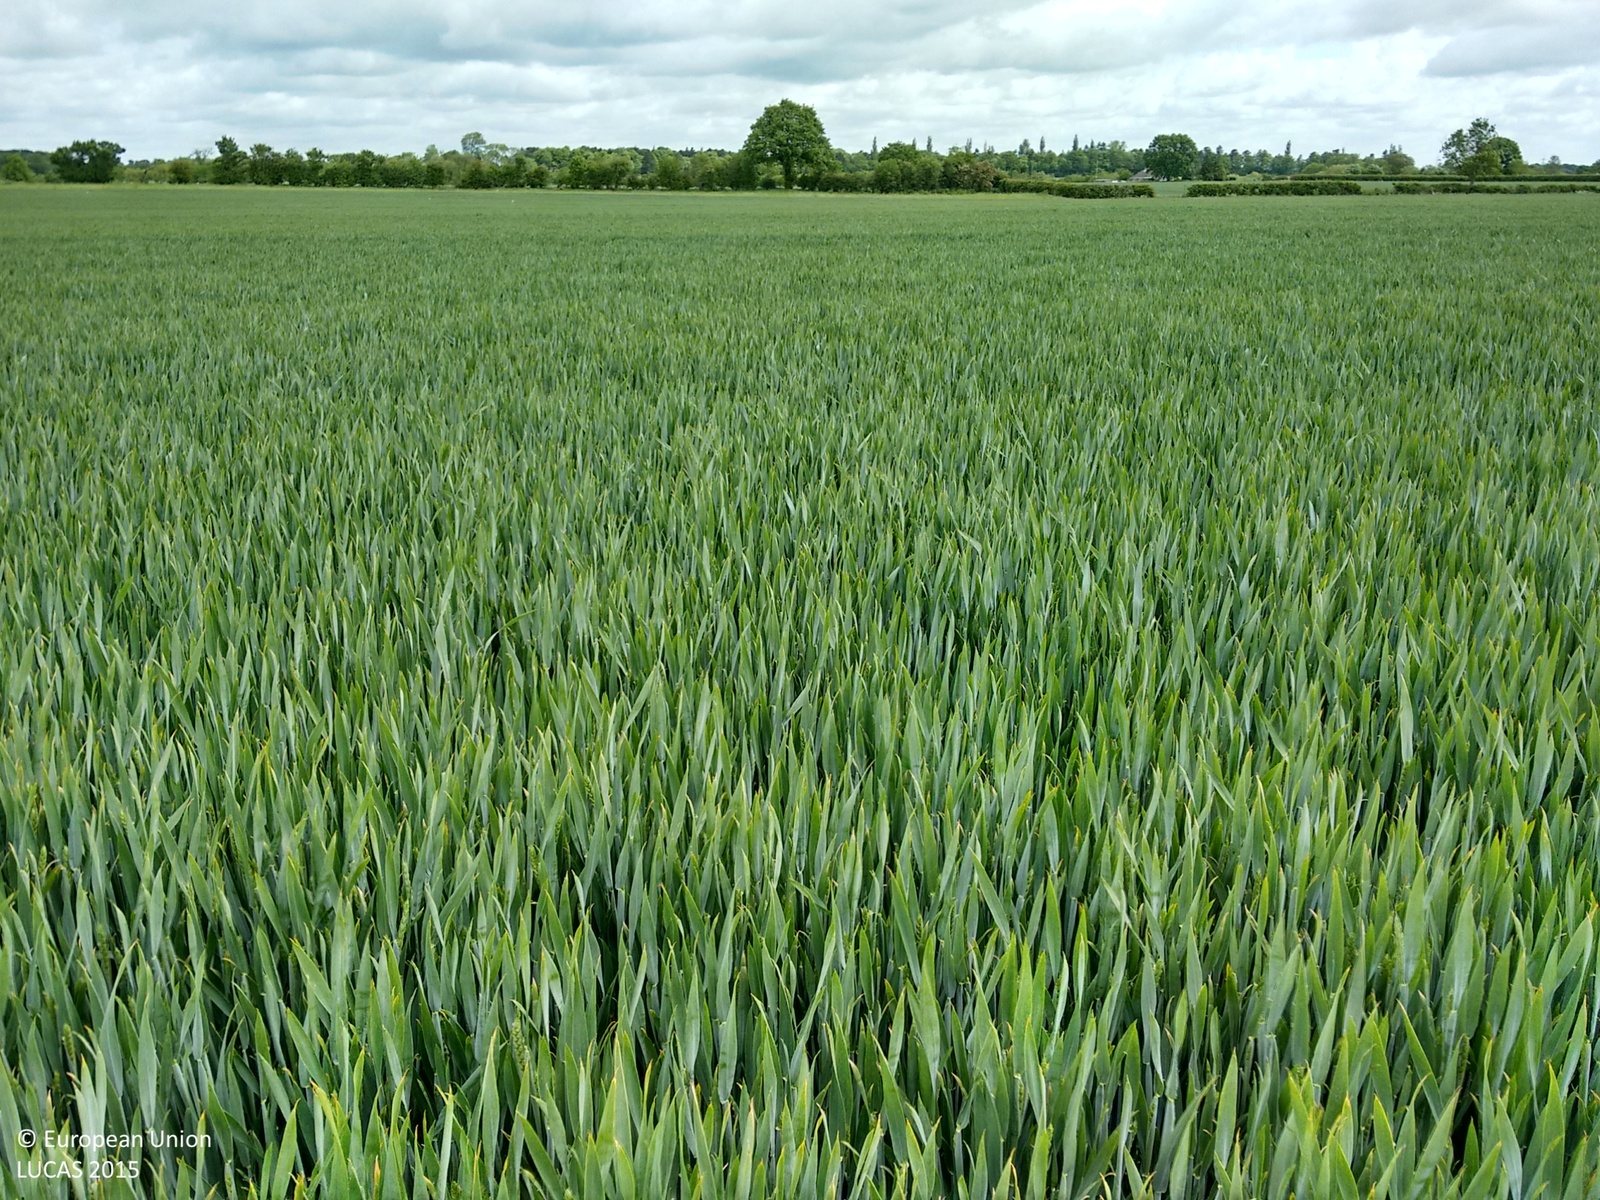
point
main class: Cropland
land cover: Common wheat
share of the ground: > 75 %
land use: Agriculture (excluding fallow land and kitchen gardens)
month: June
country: GB
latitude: 52.2135
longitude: -0.3547
